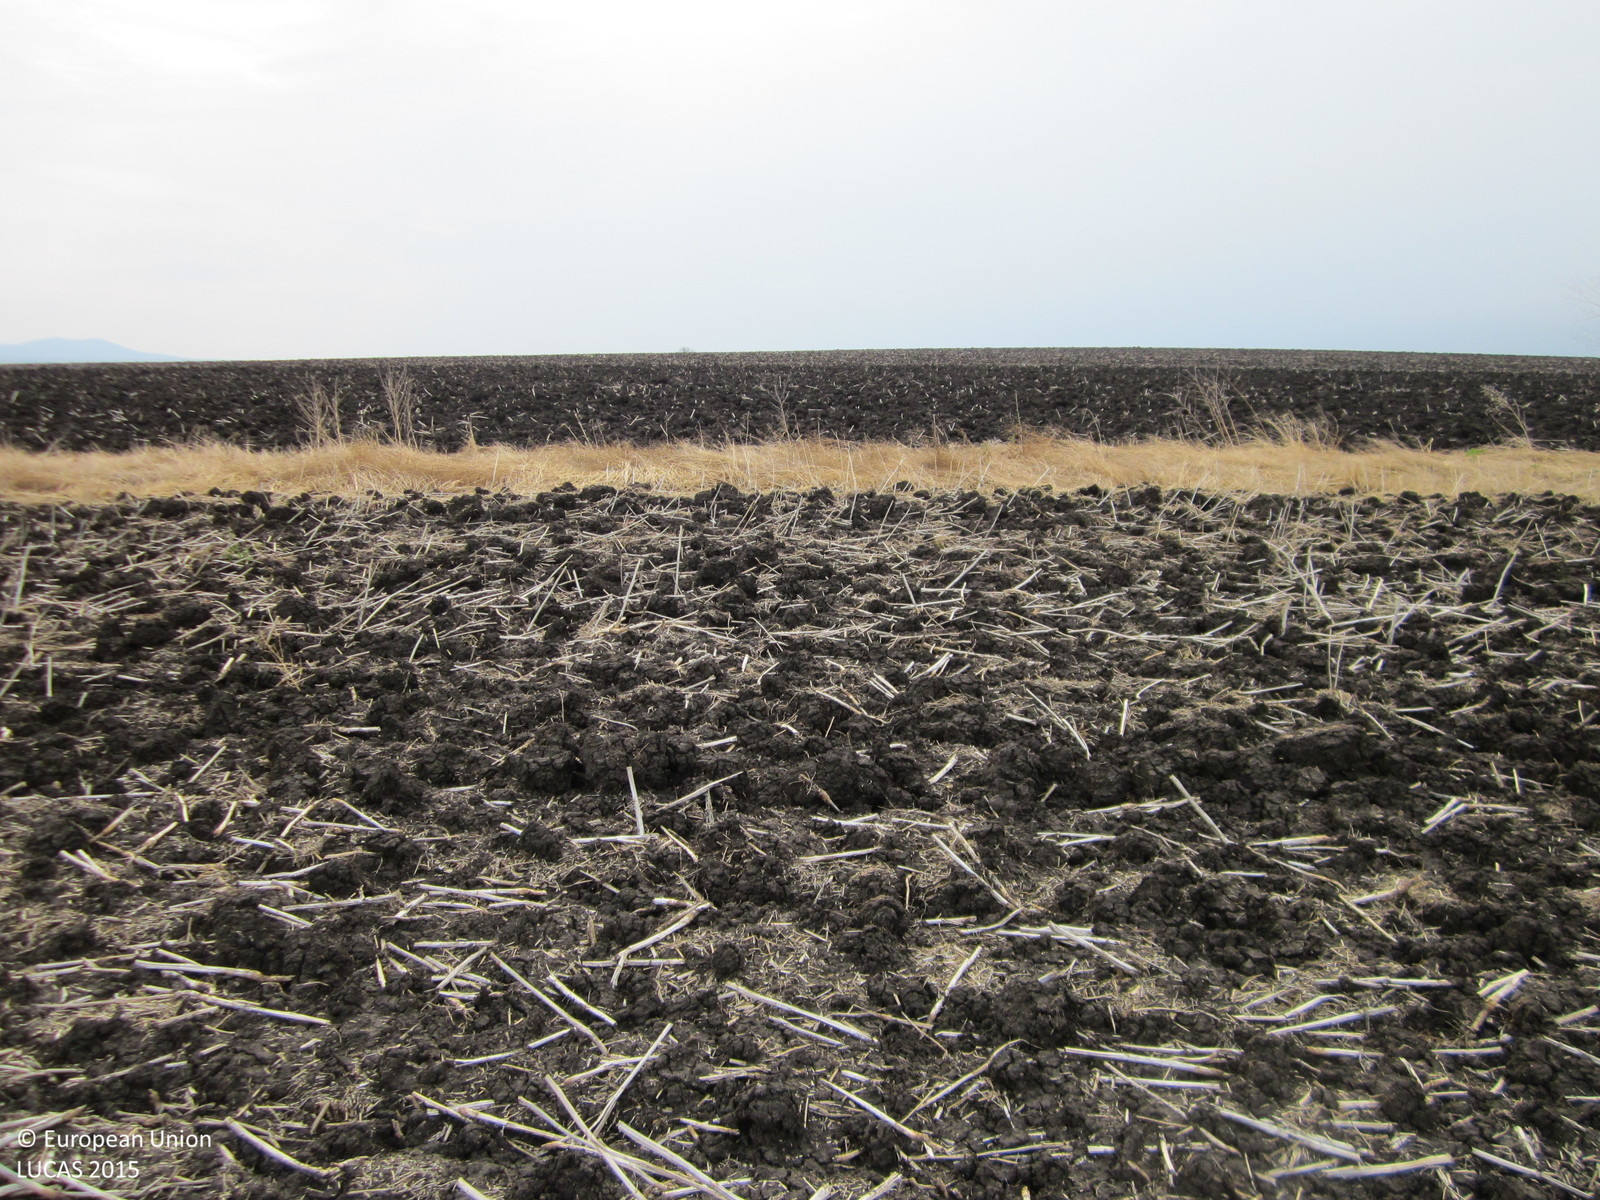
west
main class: Cropland
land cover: Sunflower
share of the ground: 10 - 25 %
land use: Agriculture (excluding fallow land and kitchen gardens)
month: August
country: BG
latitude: 42.4575
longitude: 26.9946
